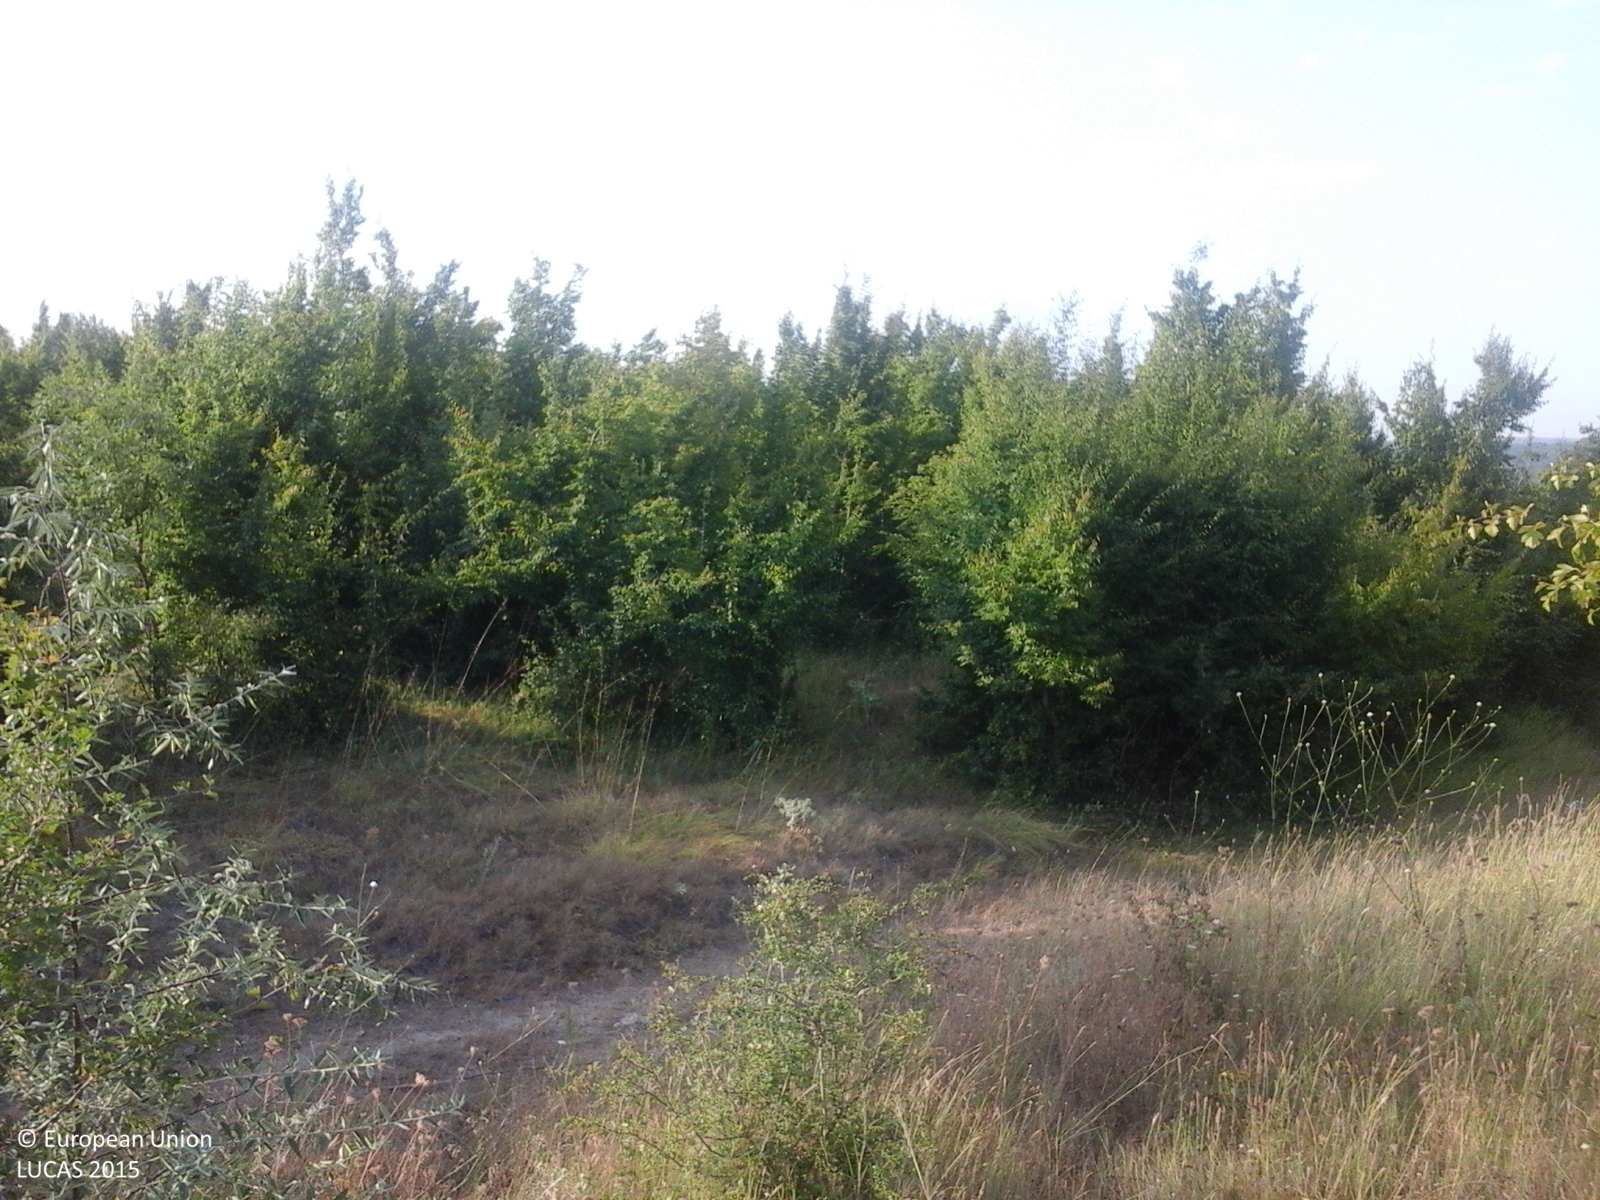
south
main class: Grassland
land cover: Grassland with sparse tree/shrub cover
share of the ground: > 75 %
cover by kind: herbaceous plants 95 %, broadleaved forest trees 5 %
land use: Semi-natural and natural areas not in use
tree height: > 5 m
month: August
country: RO
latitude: 44.0579
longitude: 27.9648
